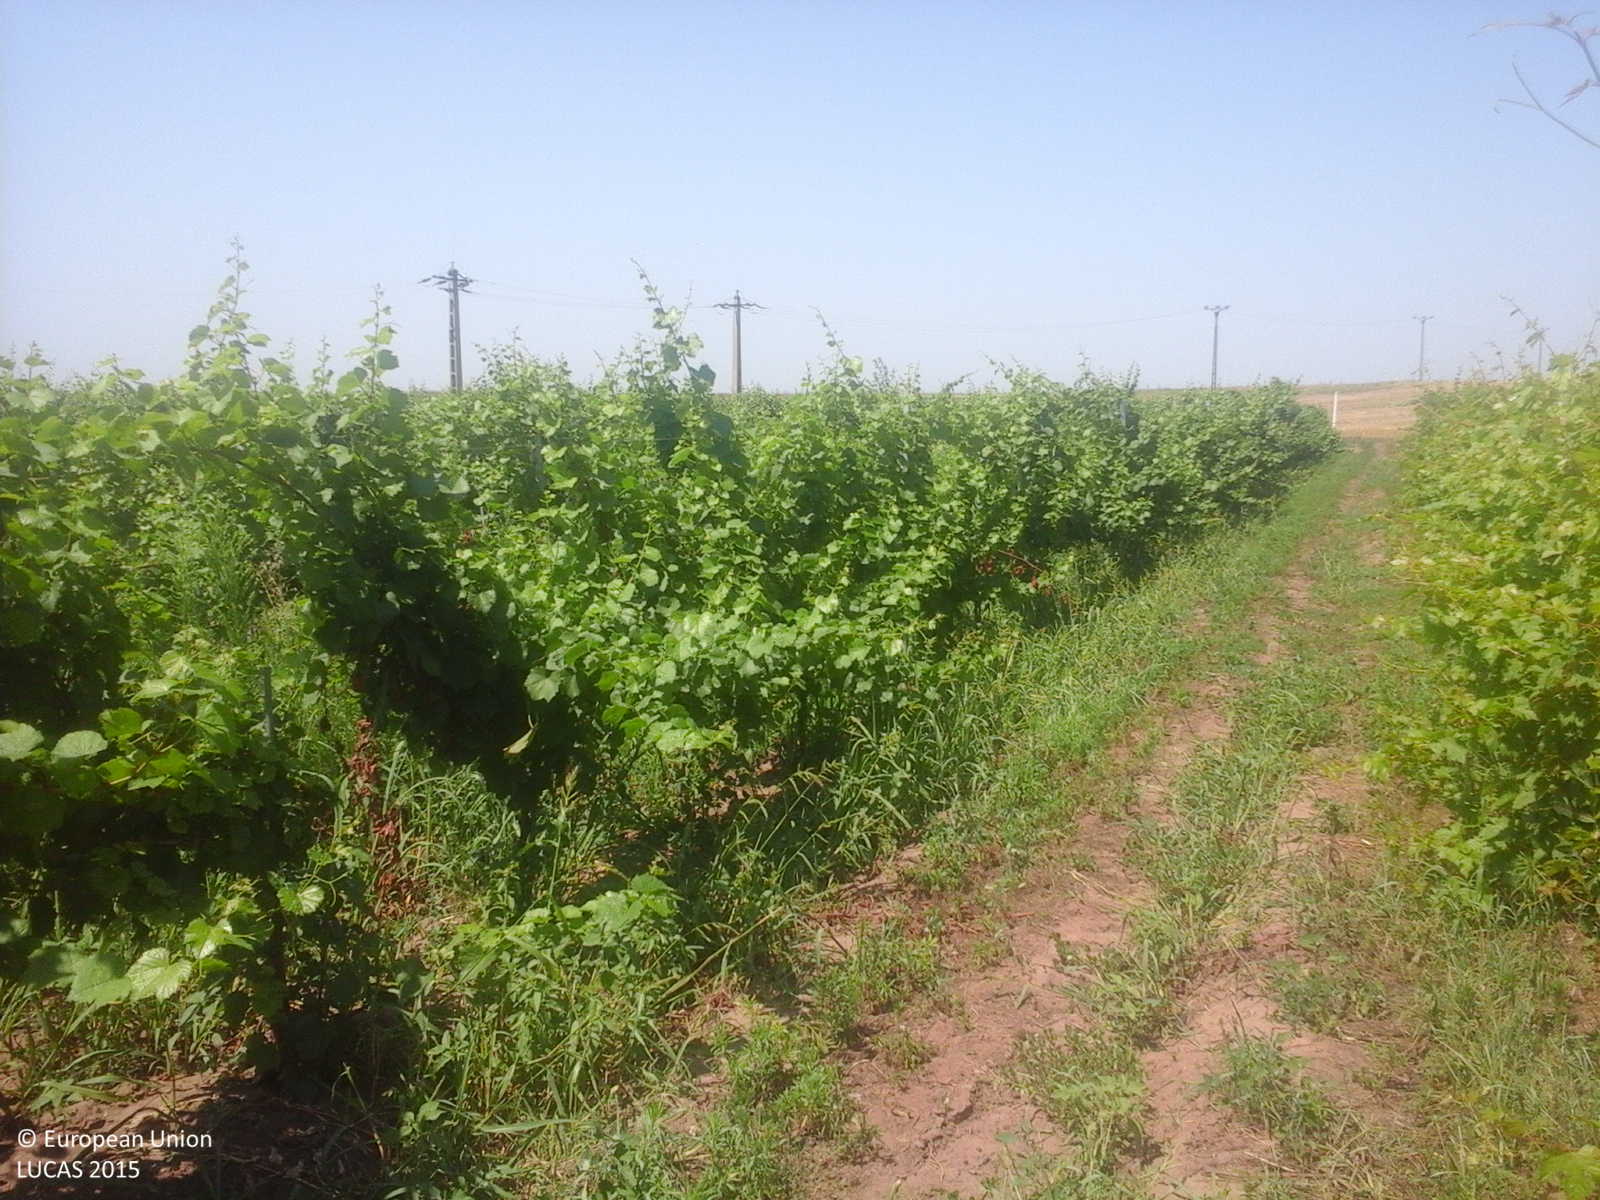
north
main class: Cropland
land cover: Vineyards
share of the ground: > 75 %
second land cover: Grassland without tree/shrub cover
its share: 50 - 75 %
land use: Agriculture (excluding fallow land and kitchen gardens)
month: July
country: RO
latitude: 44.8806
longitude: 27.6862
